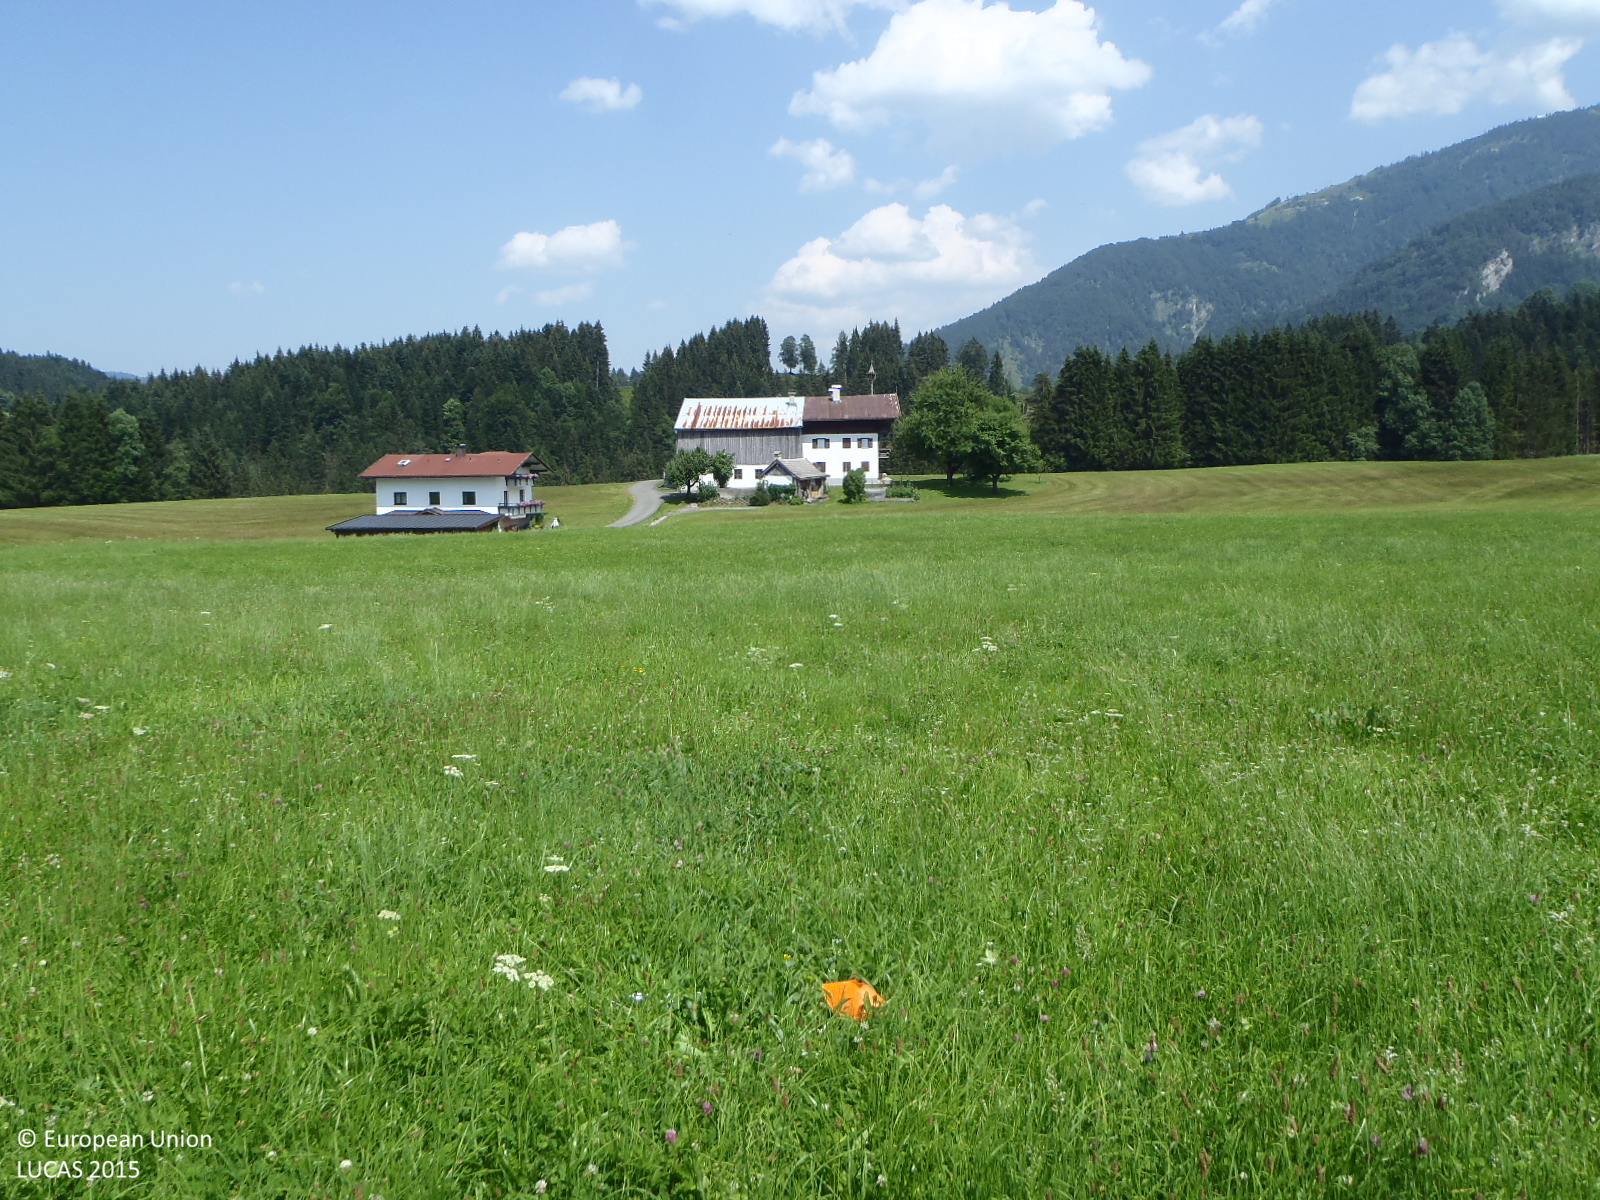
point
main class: Grassland
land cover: Grassland without tree/shrub cover
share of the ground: > 75 %
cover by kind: herbaceous plants 100 %
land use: Agriculture (excluding fallow land and kitchen gardens)
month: July
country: AT
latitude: 47.6397
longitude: 12.3811
